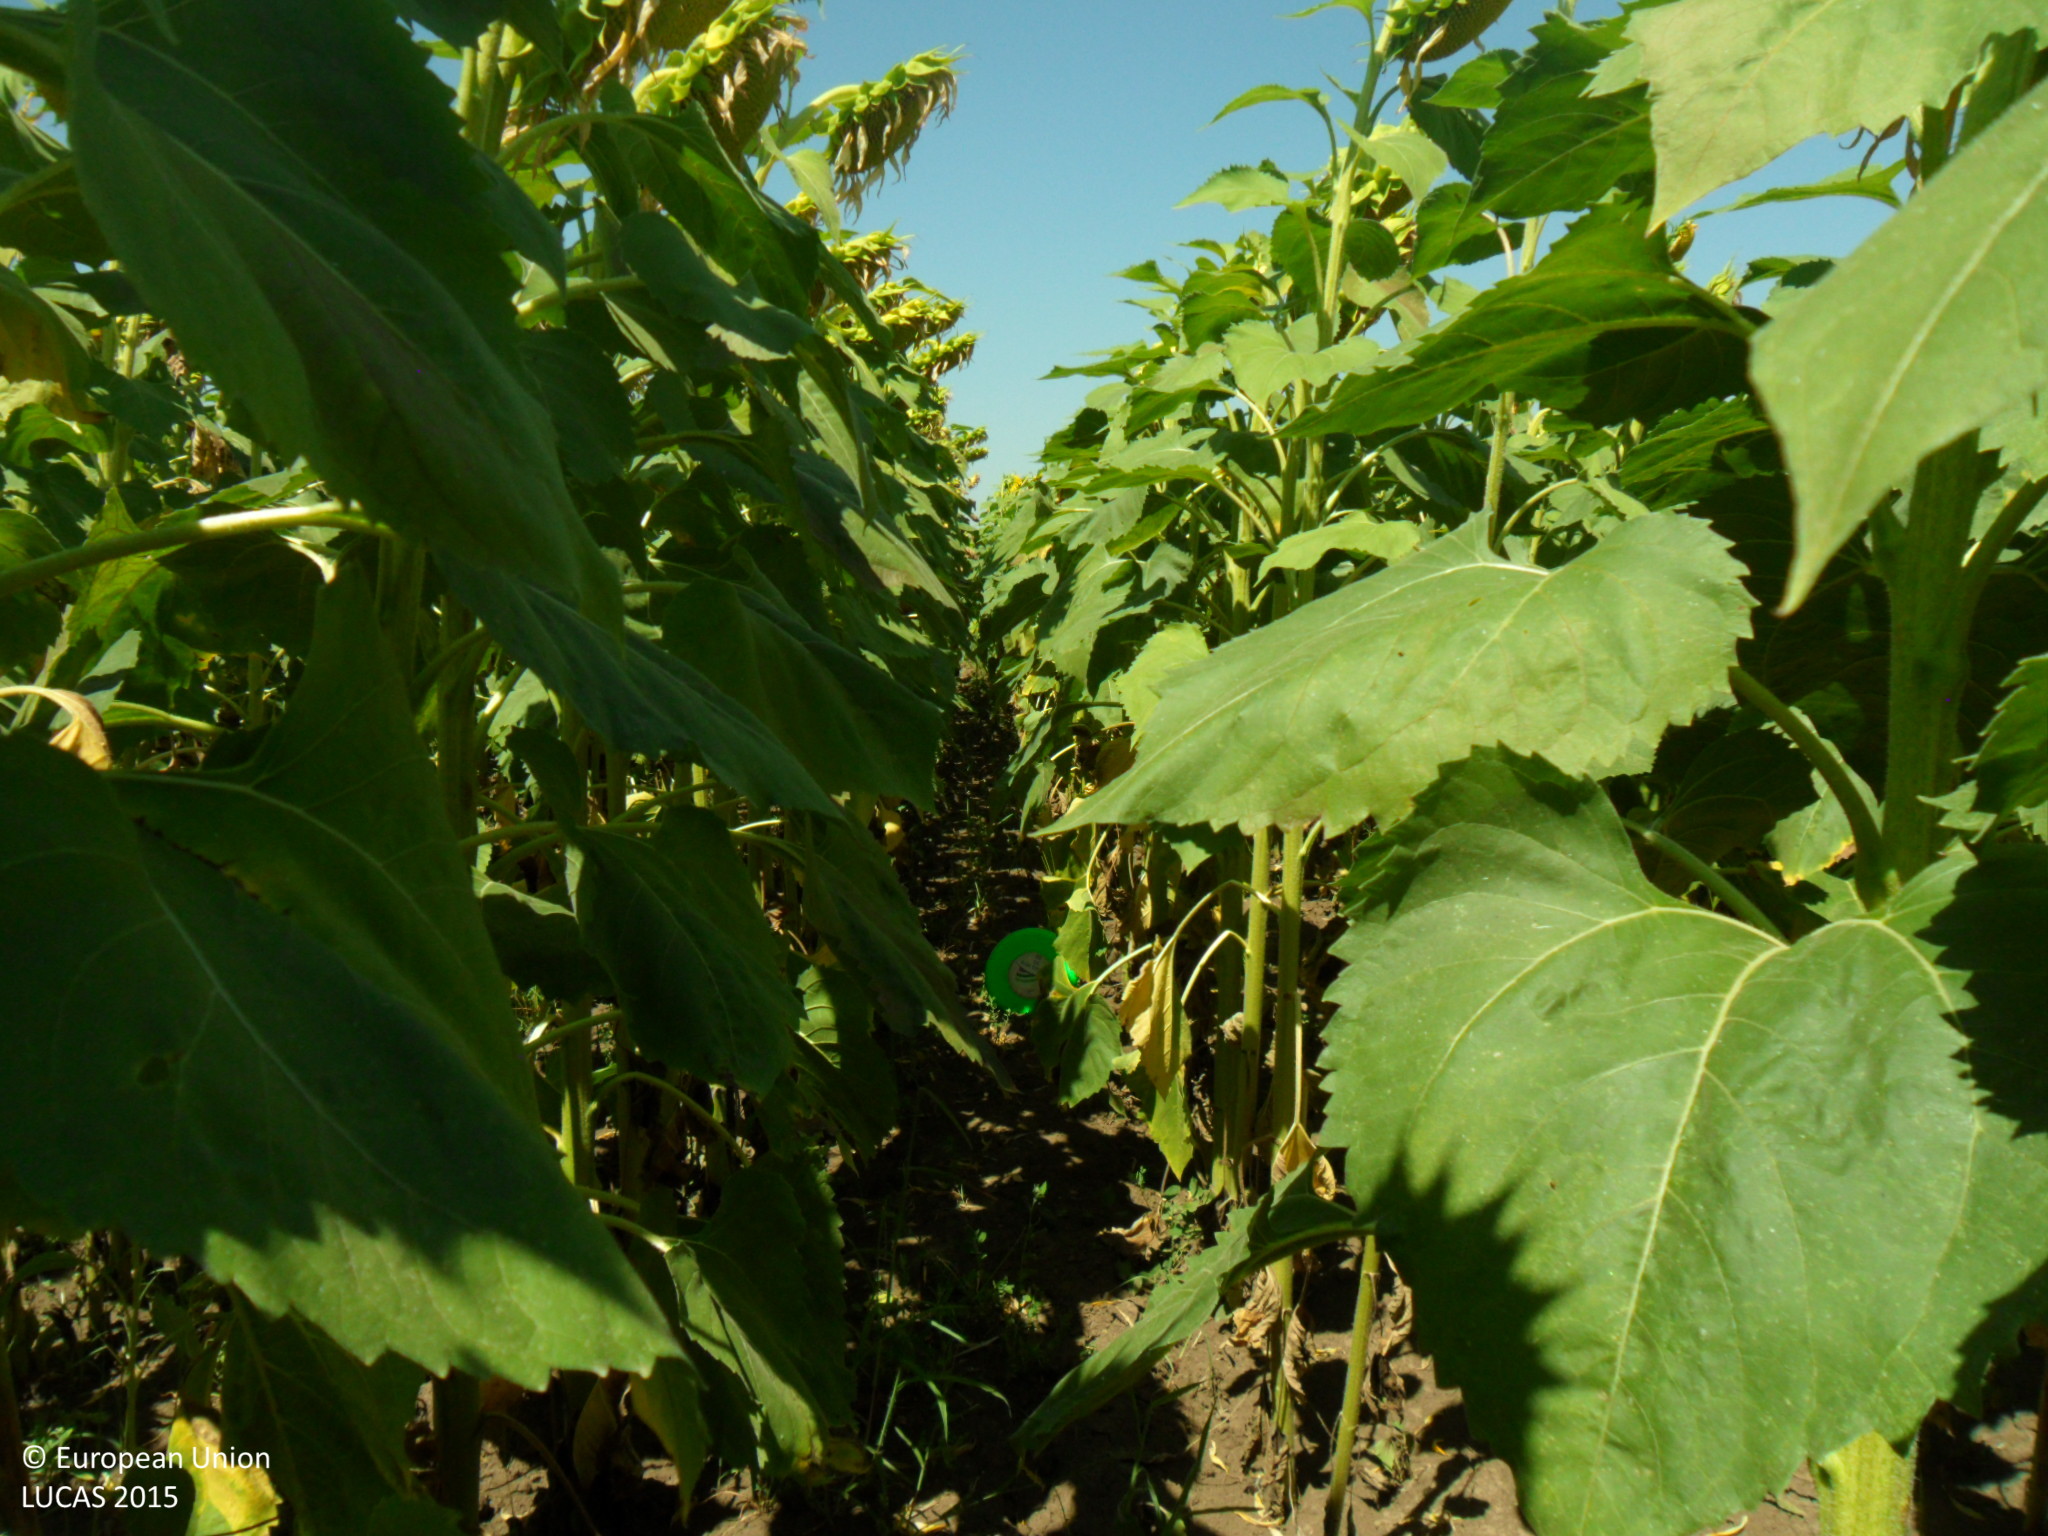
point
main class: Cropland
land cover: Sunflower
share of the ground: > 75 %
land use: Agriculture (excluding fallow land and kitchen gardens)
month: July
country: BG
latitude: 43.8415
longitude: 26.4123
